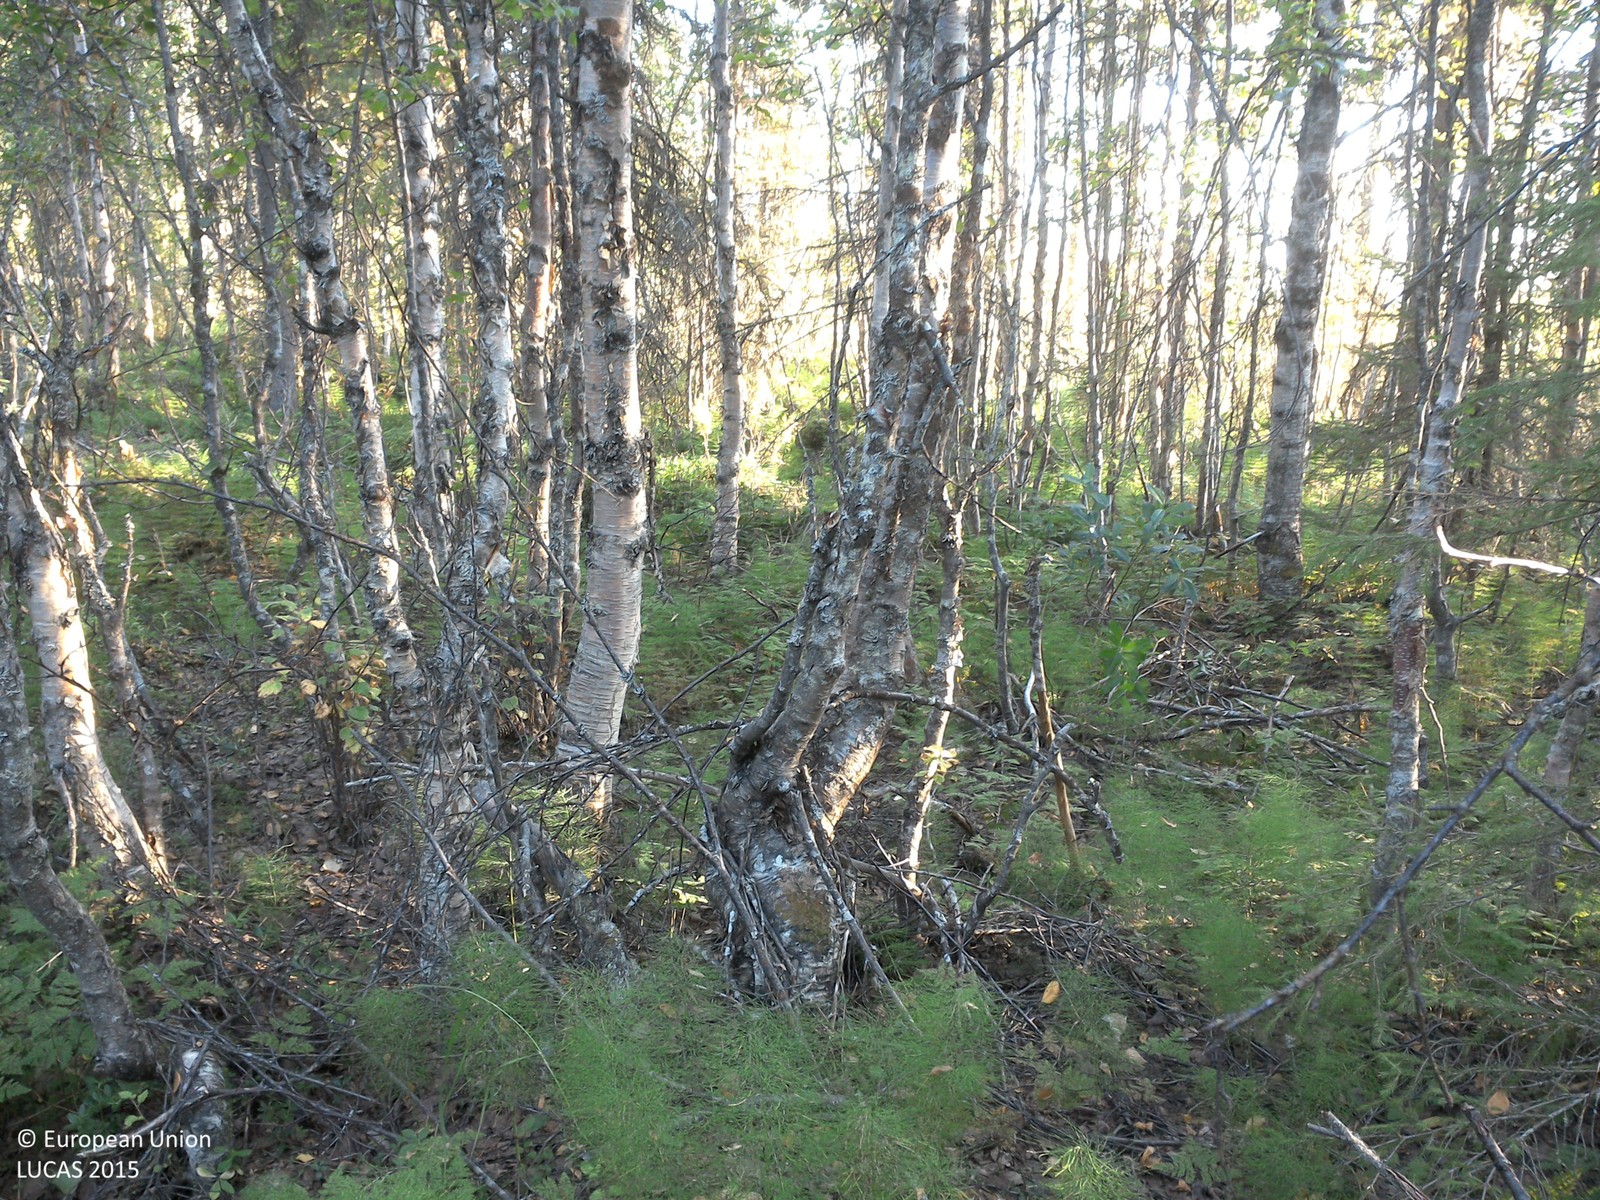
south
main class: Woodland
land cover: Other mixed woodland
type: boreal forest
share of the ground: 25 - 50 %
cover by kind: herbaceous plants 45 %, coniferous forest trees 20 %, broadleaved forest trees 20 %, shrubs 5 %
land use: Forestry
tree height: > 5 m
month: August
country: SE
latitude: 67.1286
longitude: 21.7846
